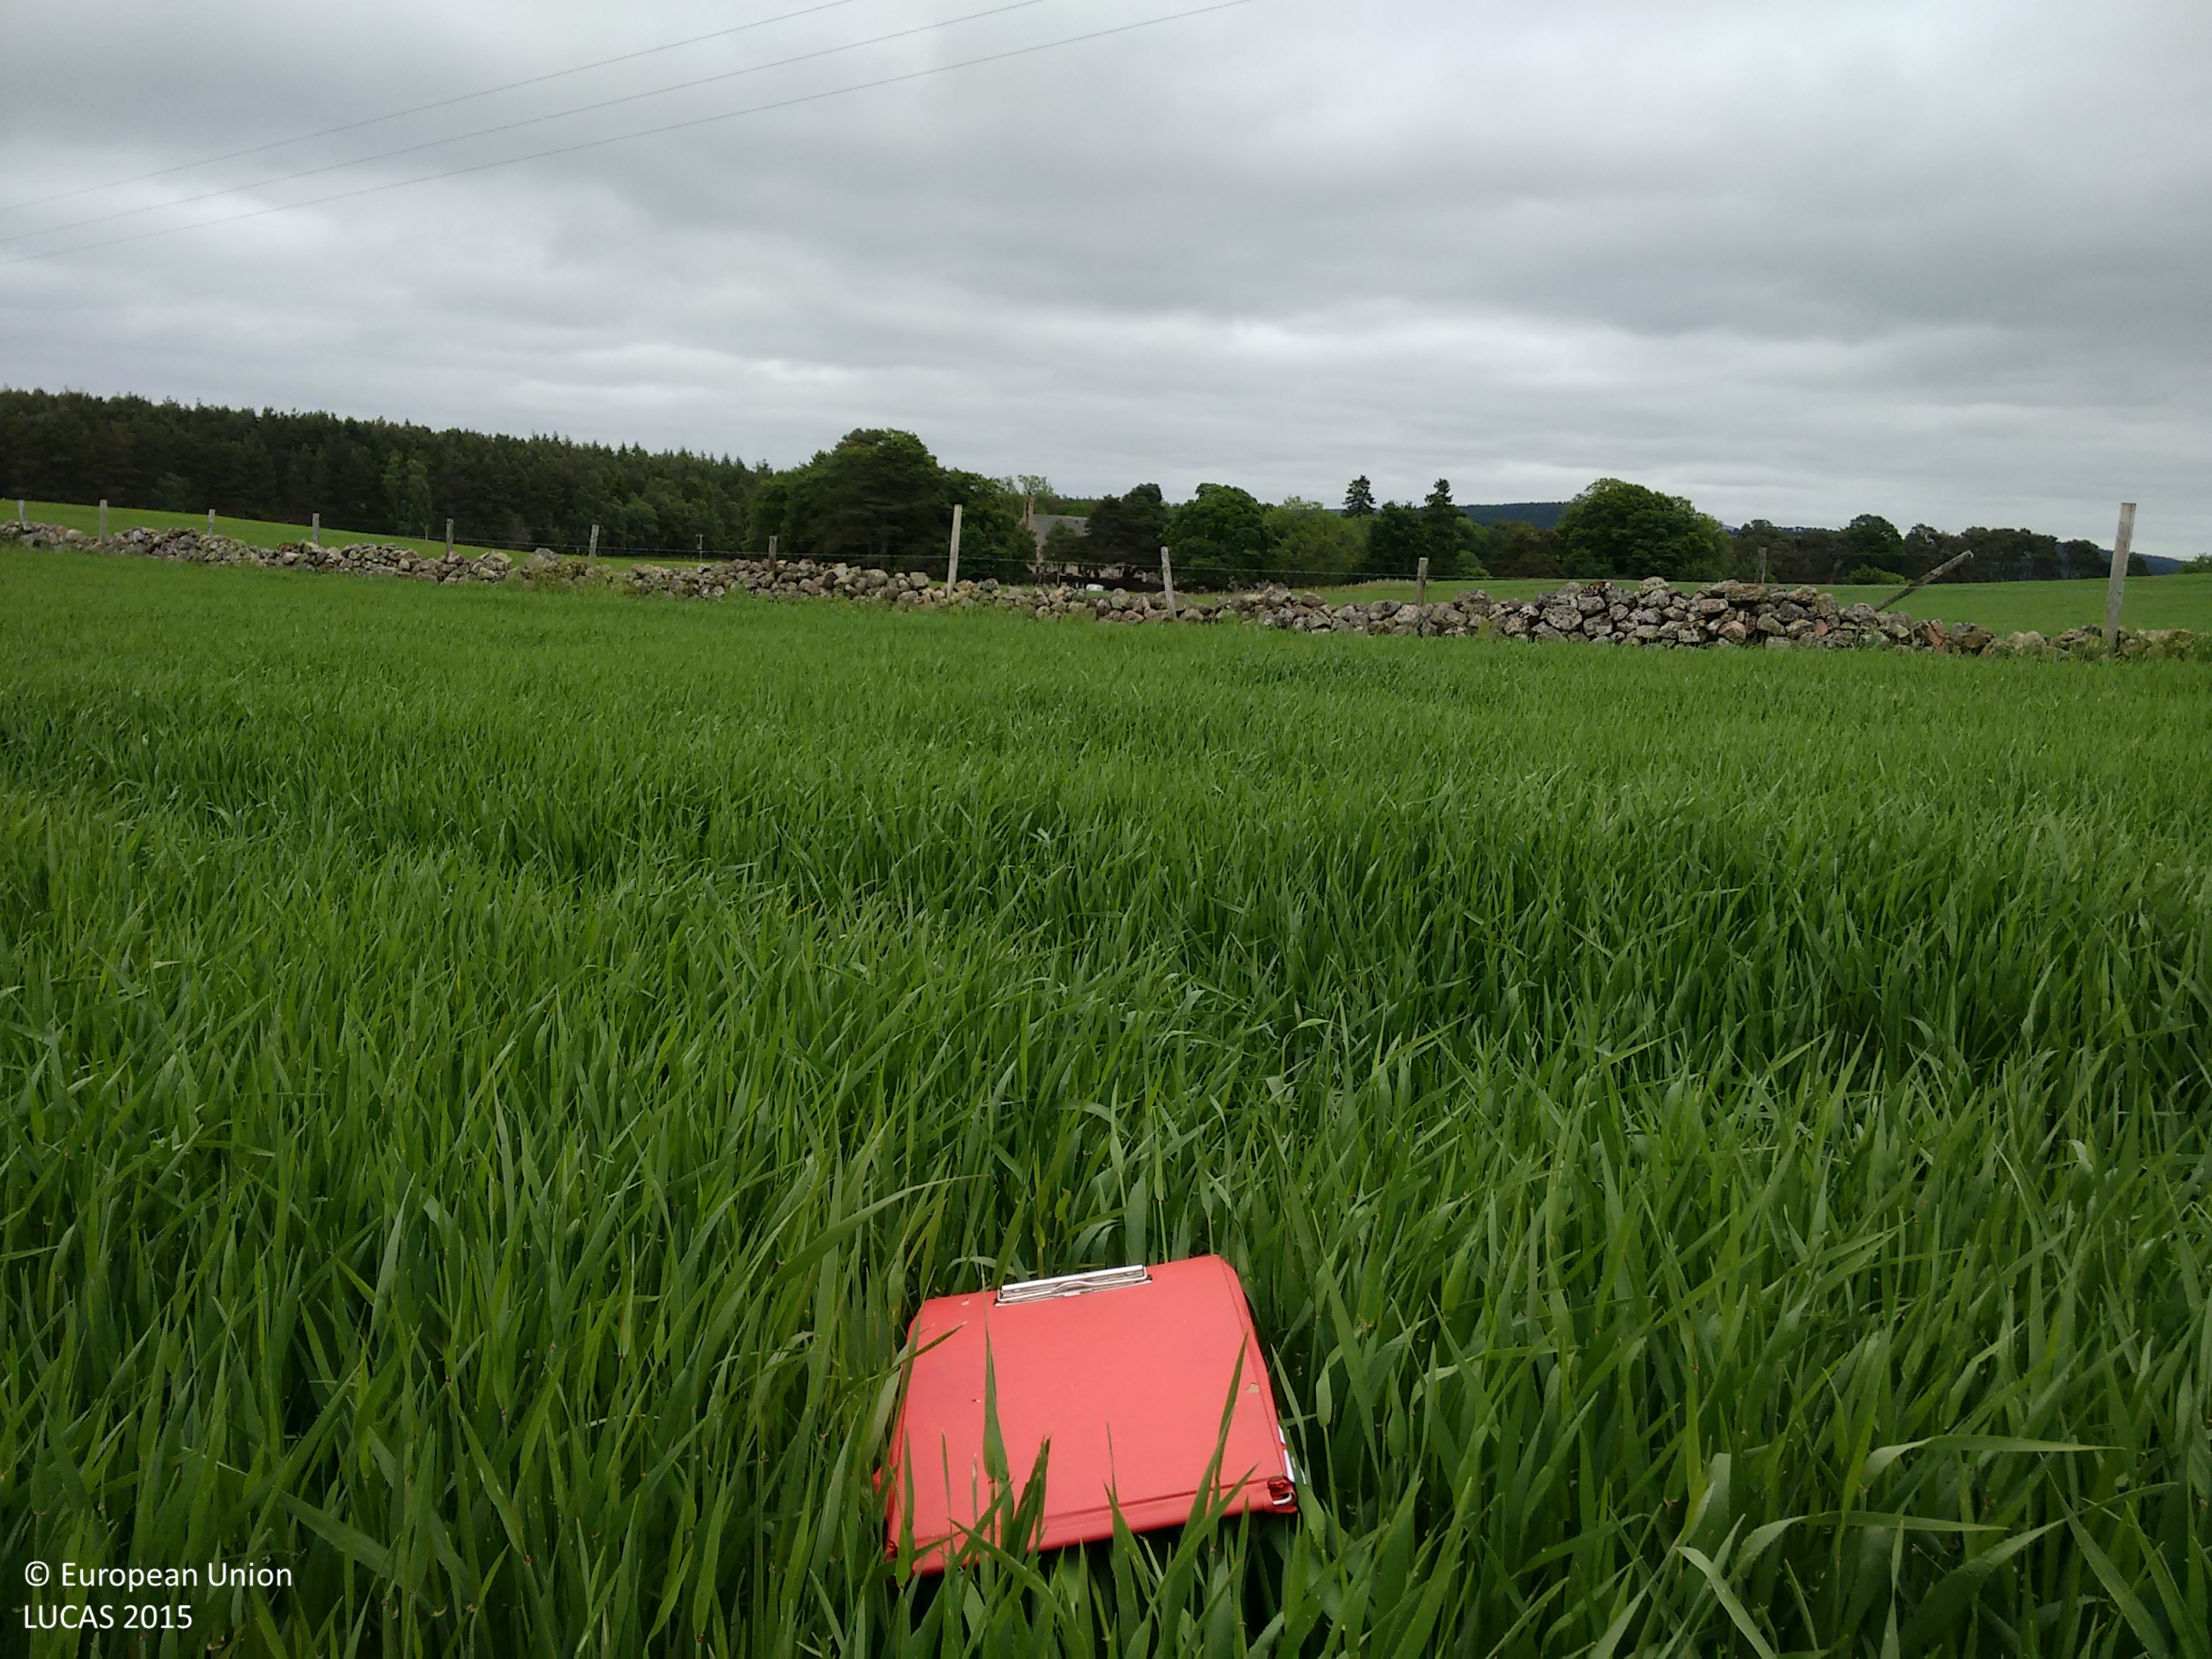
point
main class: Cropland
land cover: Barley
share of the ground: > 75 %
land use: Agriculture (excluding fallow land and kitchen gardens)
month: June
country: GB
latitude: 57.0628
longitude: -2.7400
